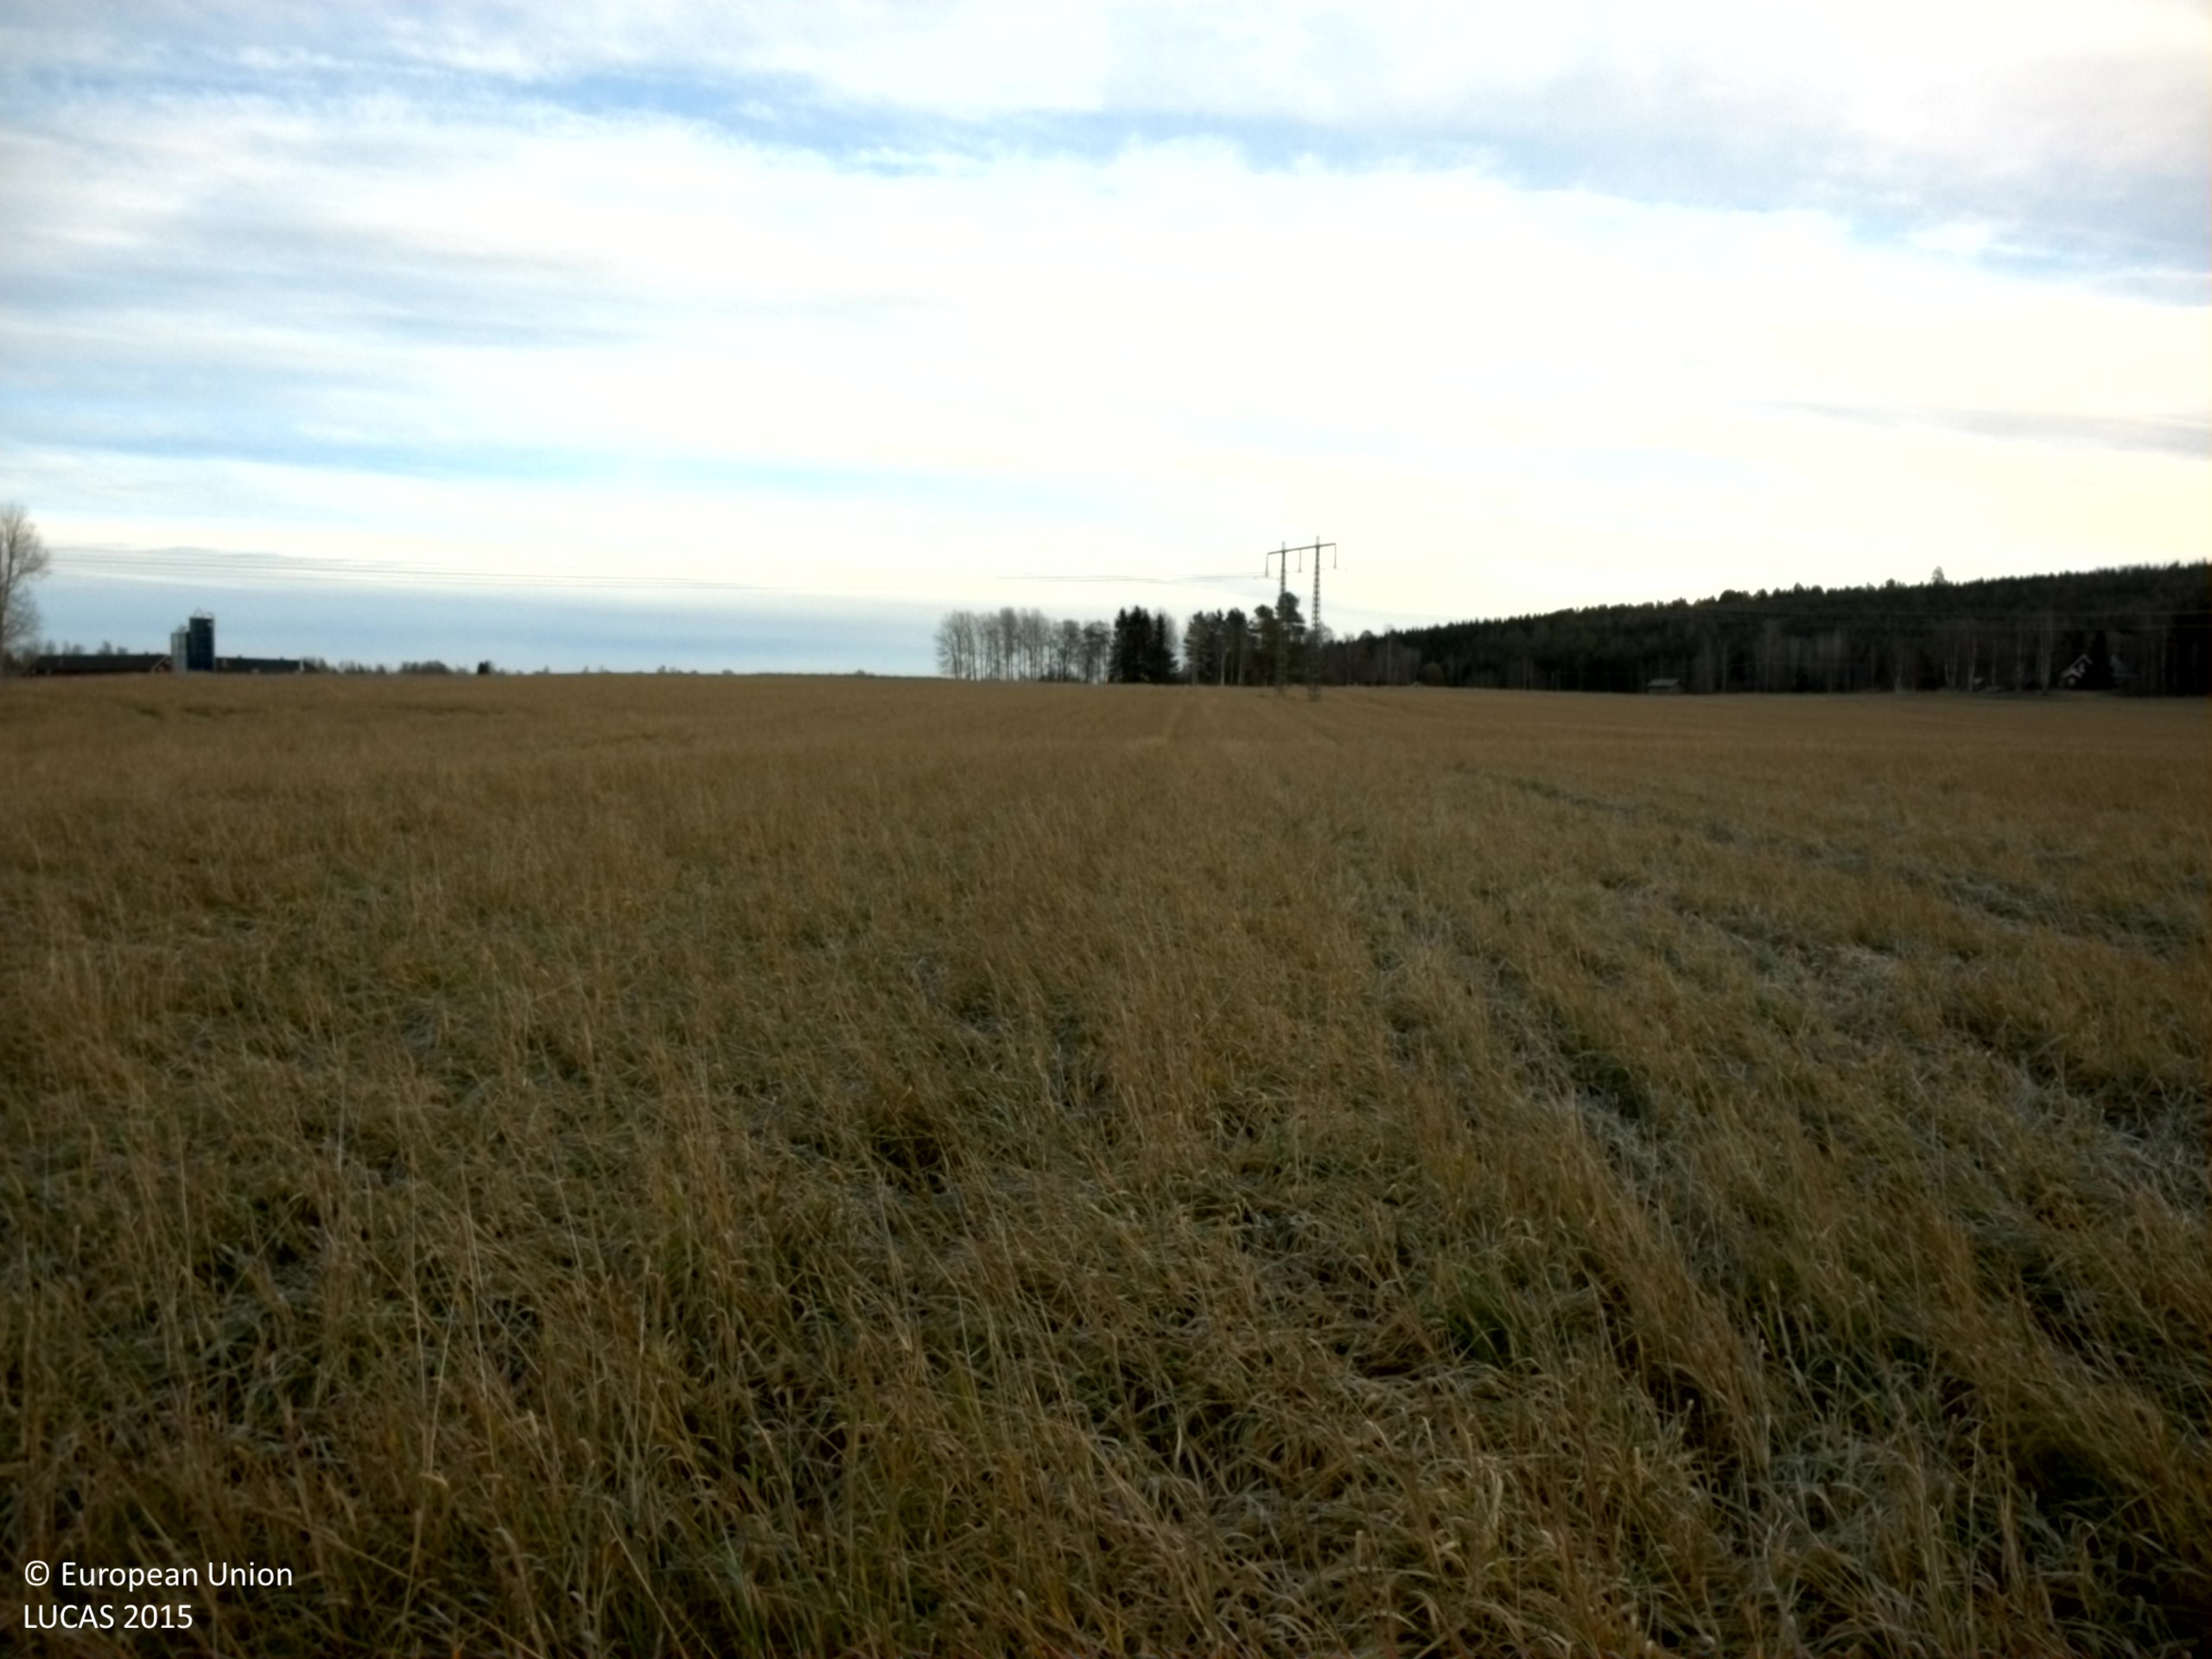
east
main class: Cropland
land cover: Temporary grasslands
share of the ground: > 75 %
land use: Agriculture (excluding fallow land and kitchen gardens)
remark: Harvested field
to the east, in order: Temporary grasslands; Electric lines; Temporary grasslands
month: November
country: SE
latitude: 61.2212
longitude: 16.5585
